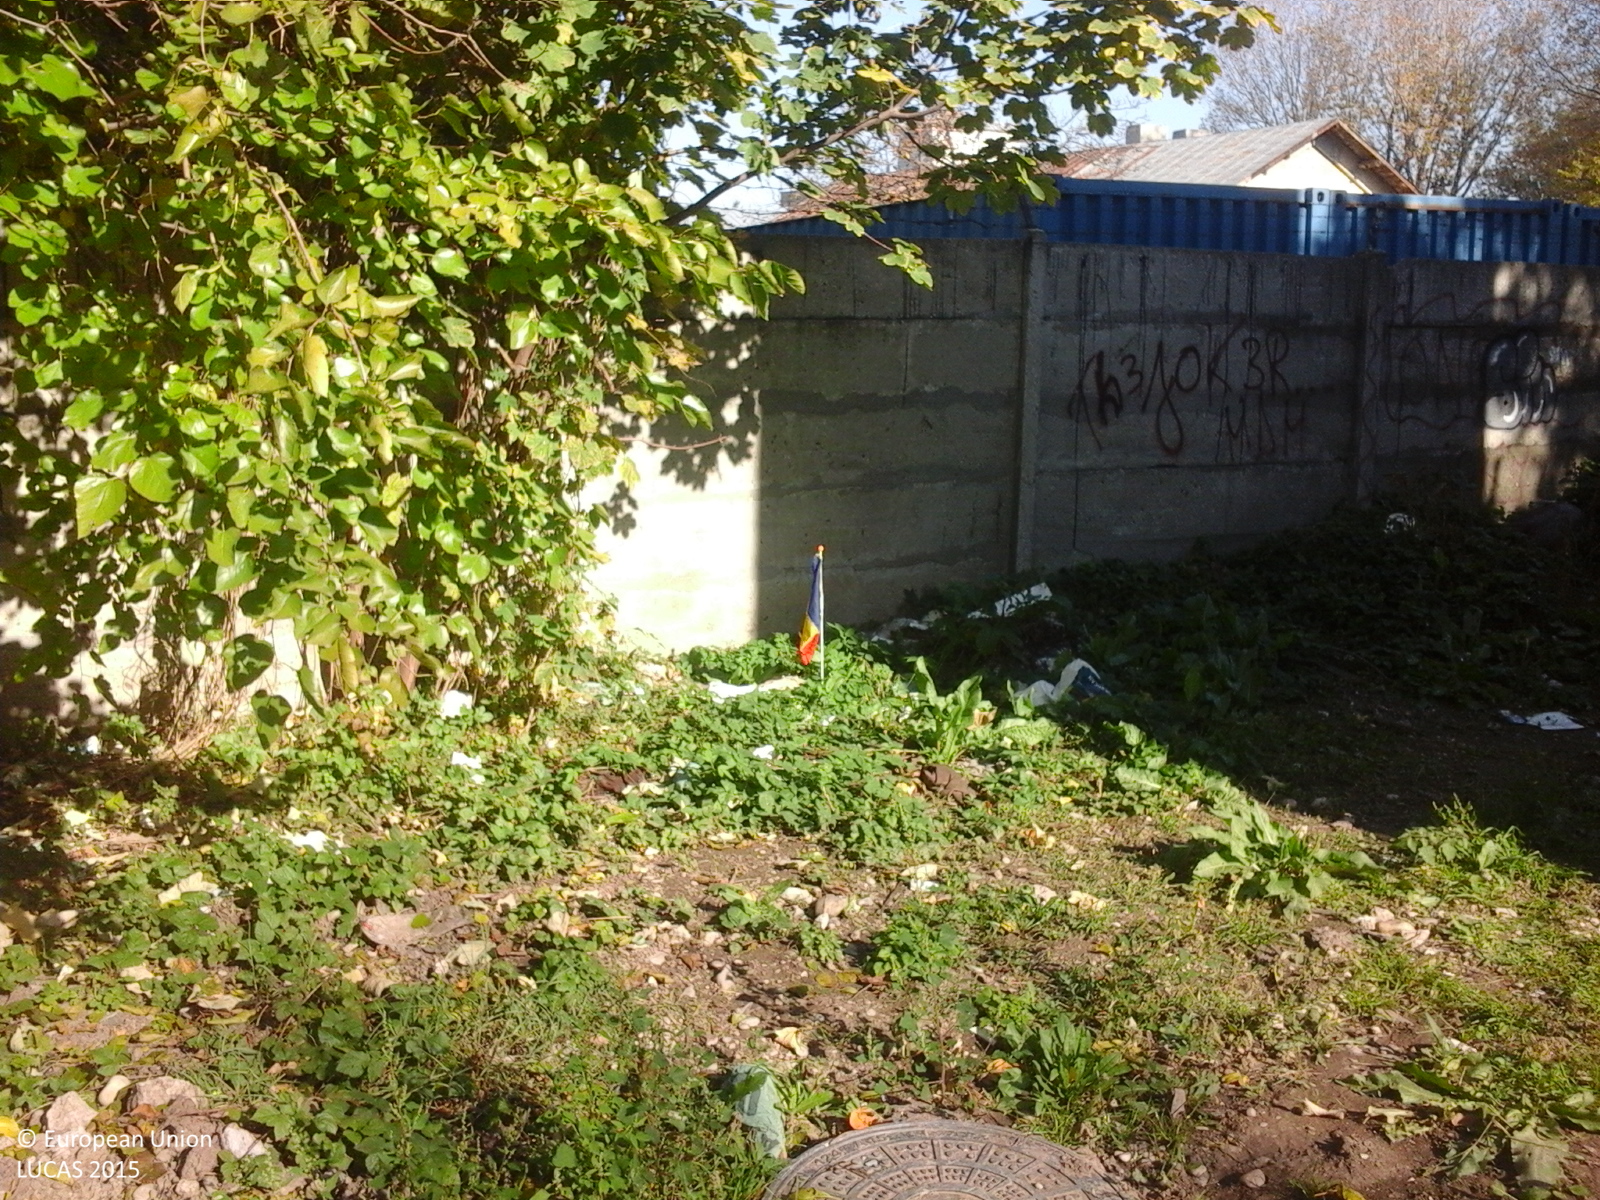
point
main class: Grassland
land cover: Spontaneously vegetated surfaces
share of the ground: > 75 %
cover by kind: herbaceous plants 60 %, consolidated bare surface 40 %
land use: Abandoned areas
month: October
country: RO
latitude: 45.6831
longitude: 27.1838
